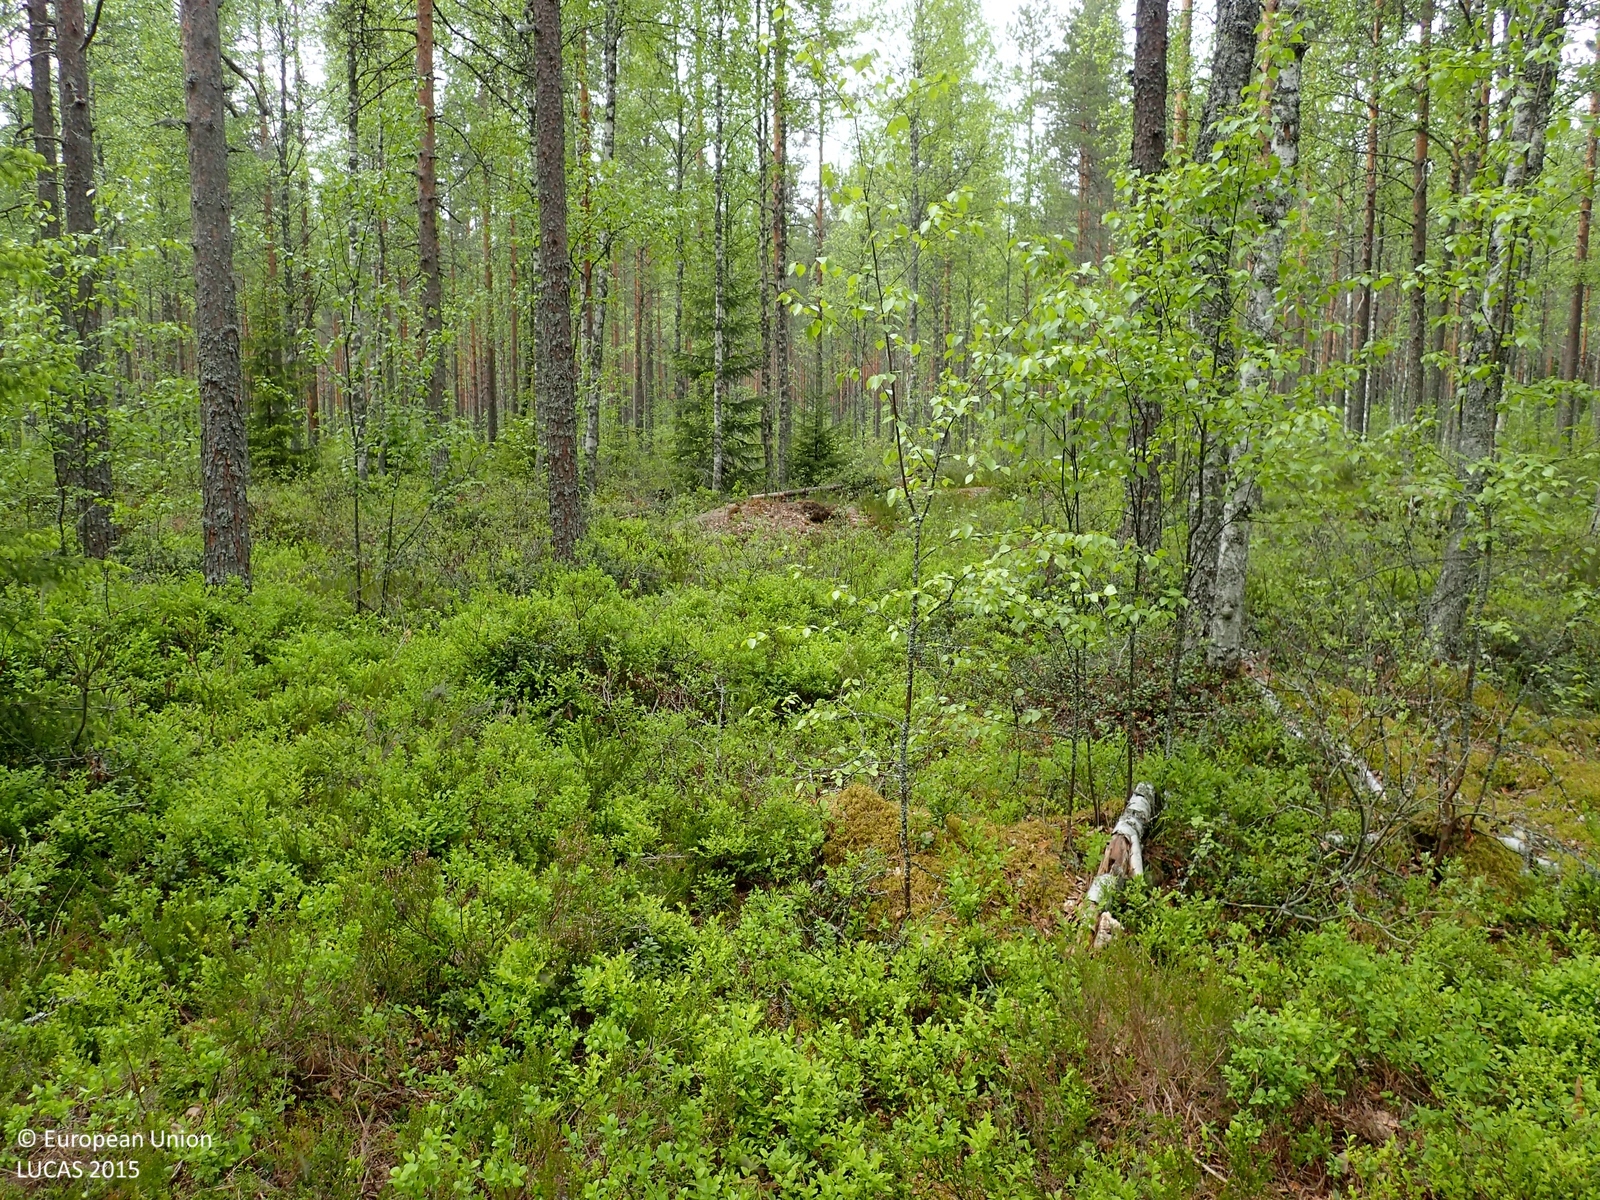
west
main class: Woodland
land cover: Pine dominated mixed woodland
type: boreal forest
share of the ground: 50 - 75 %
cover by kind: shrubs 40 %, coniferous forest trees 30 %, broadleaved forest trees 30 %
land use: Forestry
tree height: > 5 m
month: June
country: FI
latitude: 62.2702
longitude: 22.5220
